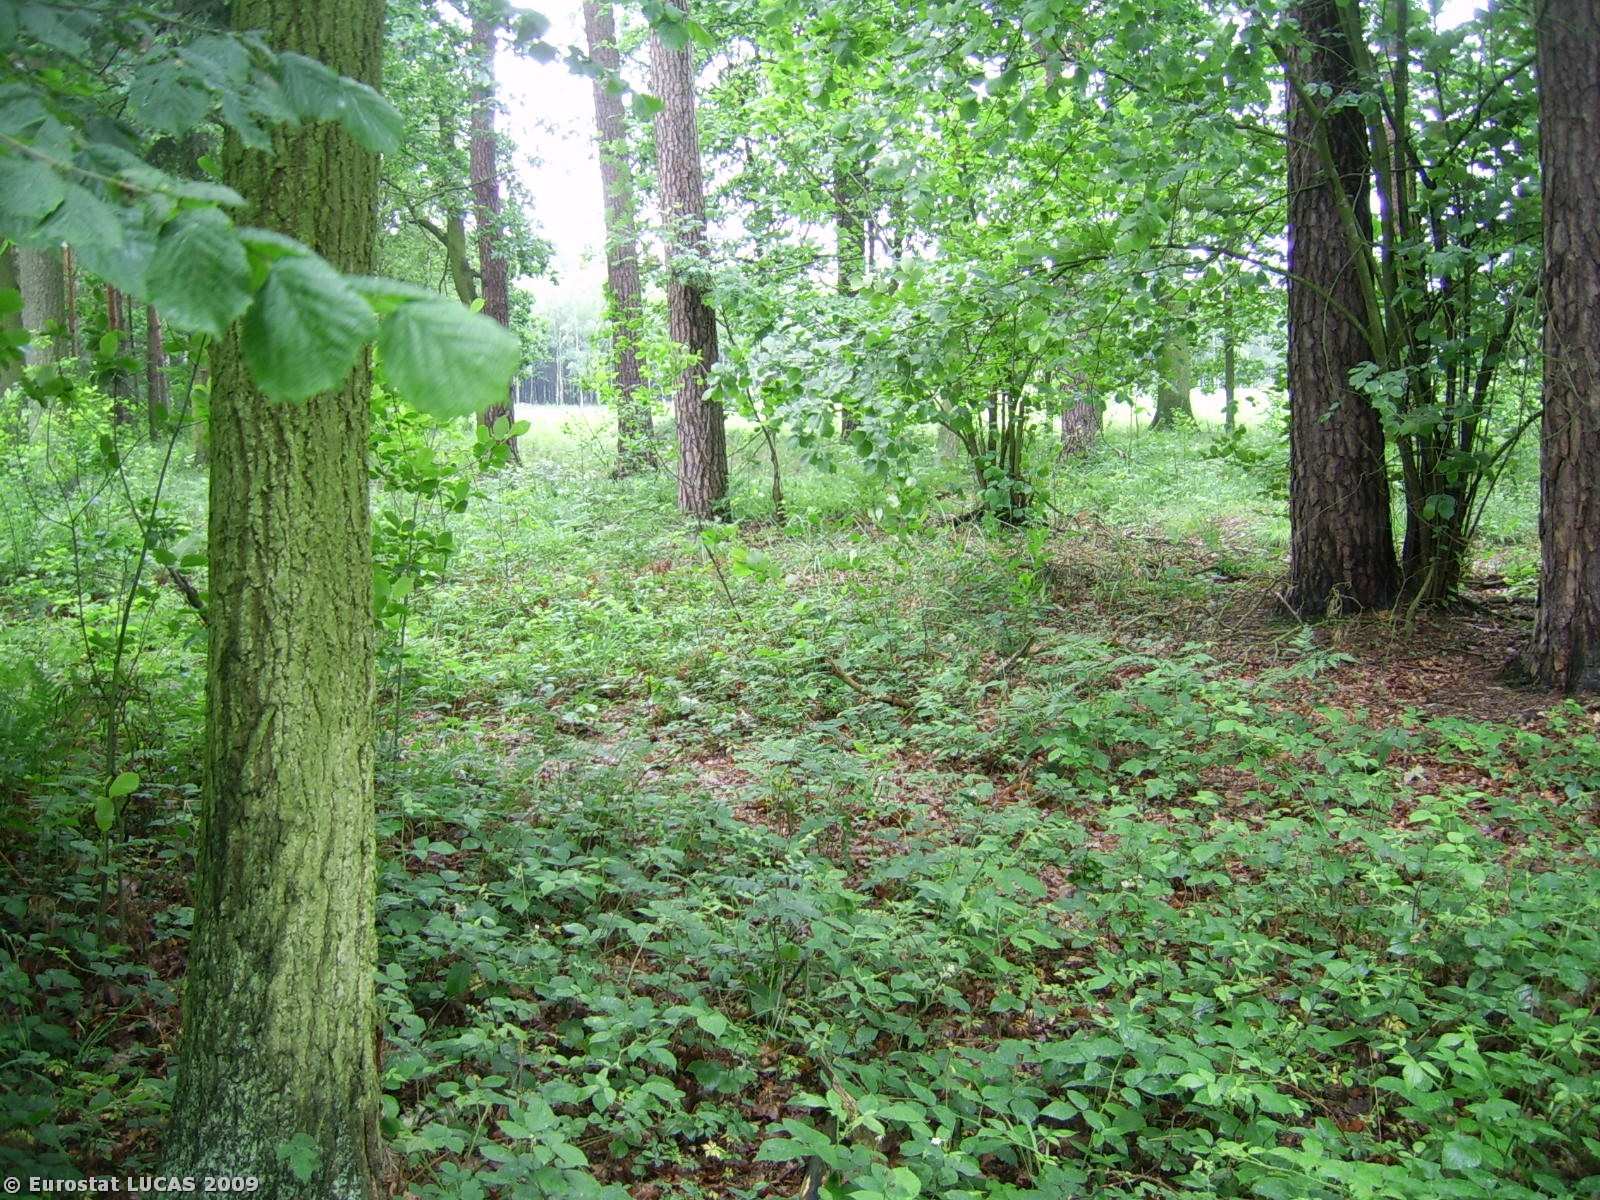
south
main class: Woodland
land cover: Mixed woodland
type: hemiboreal forest and nemoral coniferous forest and mixed broadleaved-coniferous forest
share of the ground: > 75 %
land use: Unused
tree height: > 5 m
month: June
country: PL
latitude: 51.5816
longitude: 18.0254
